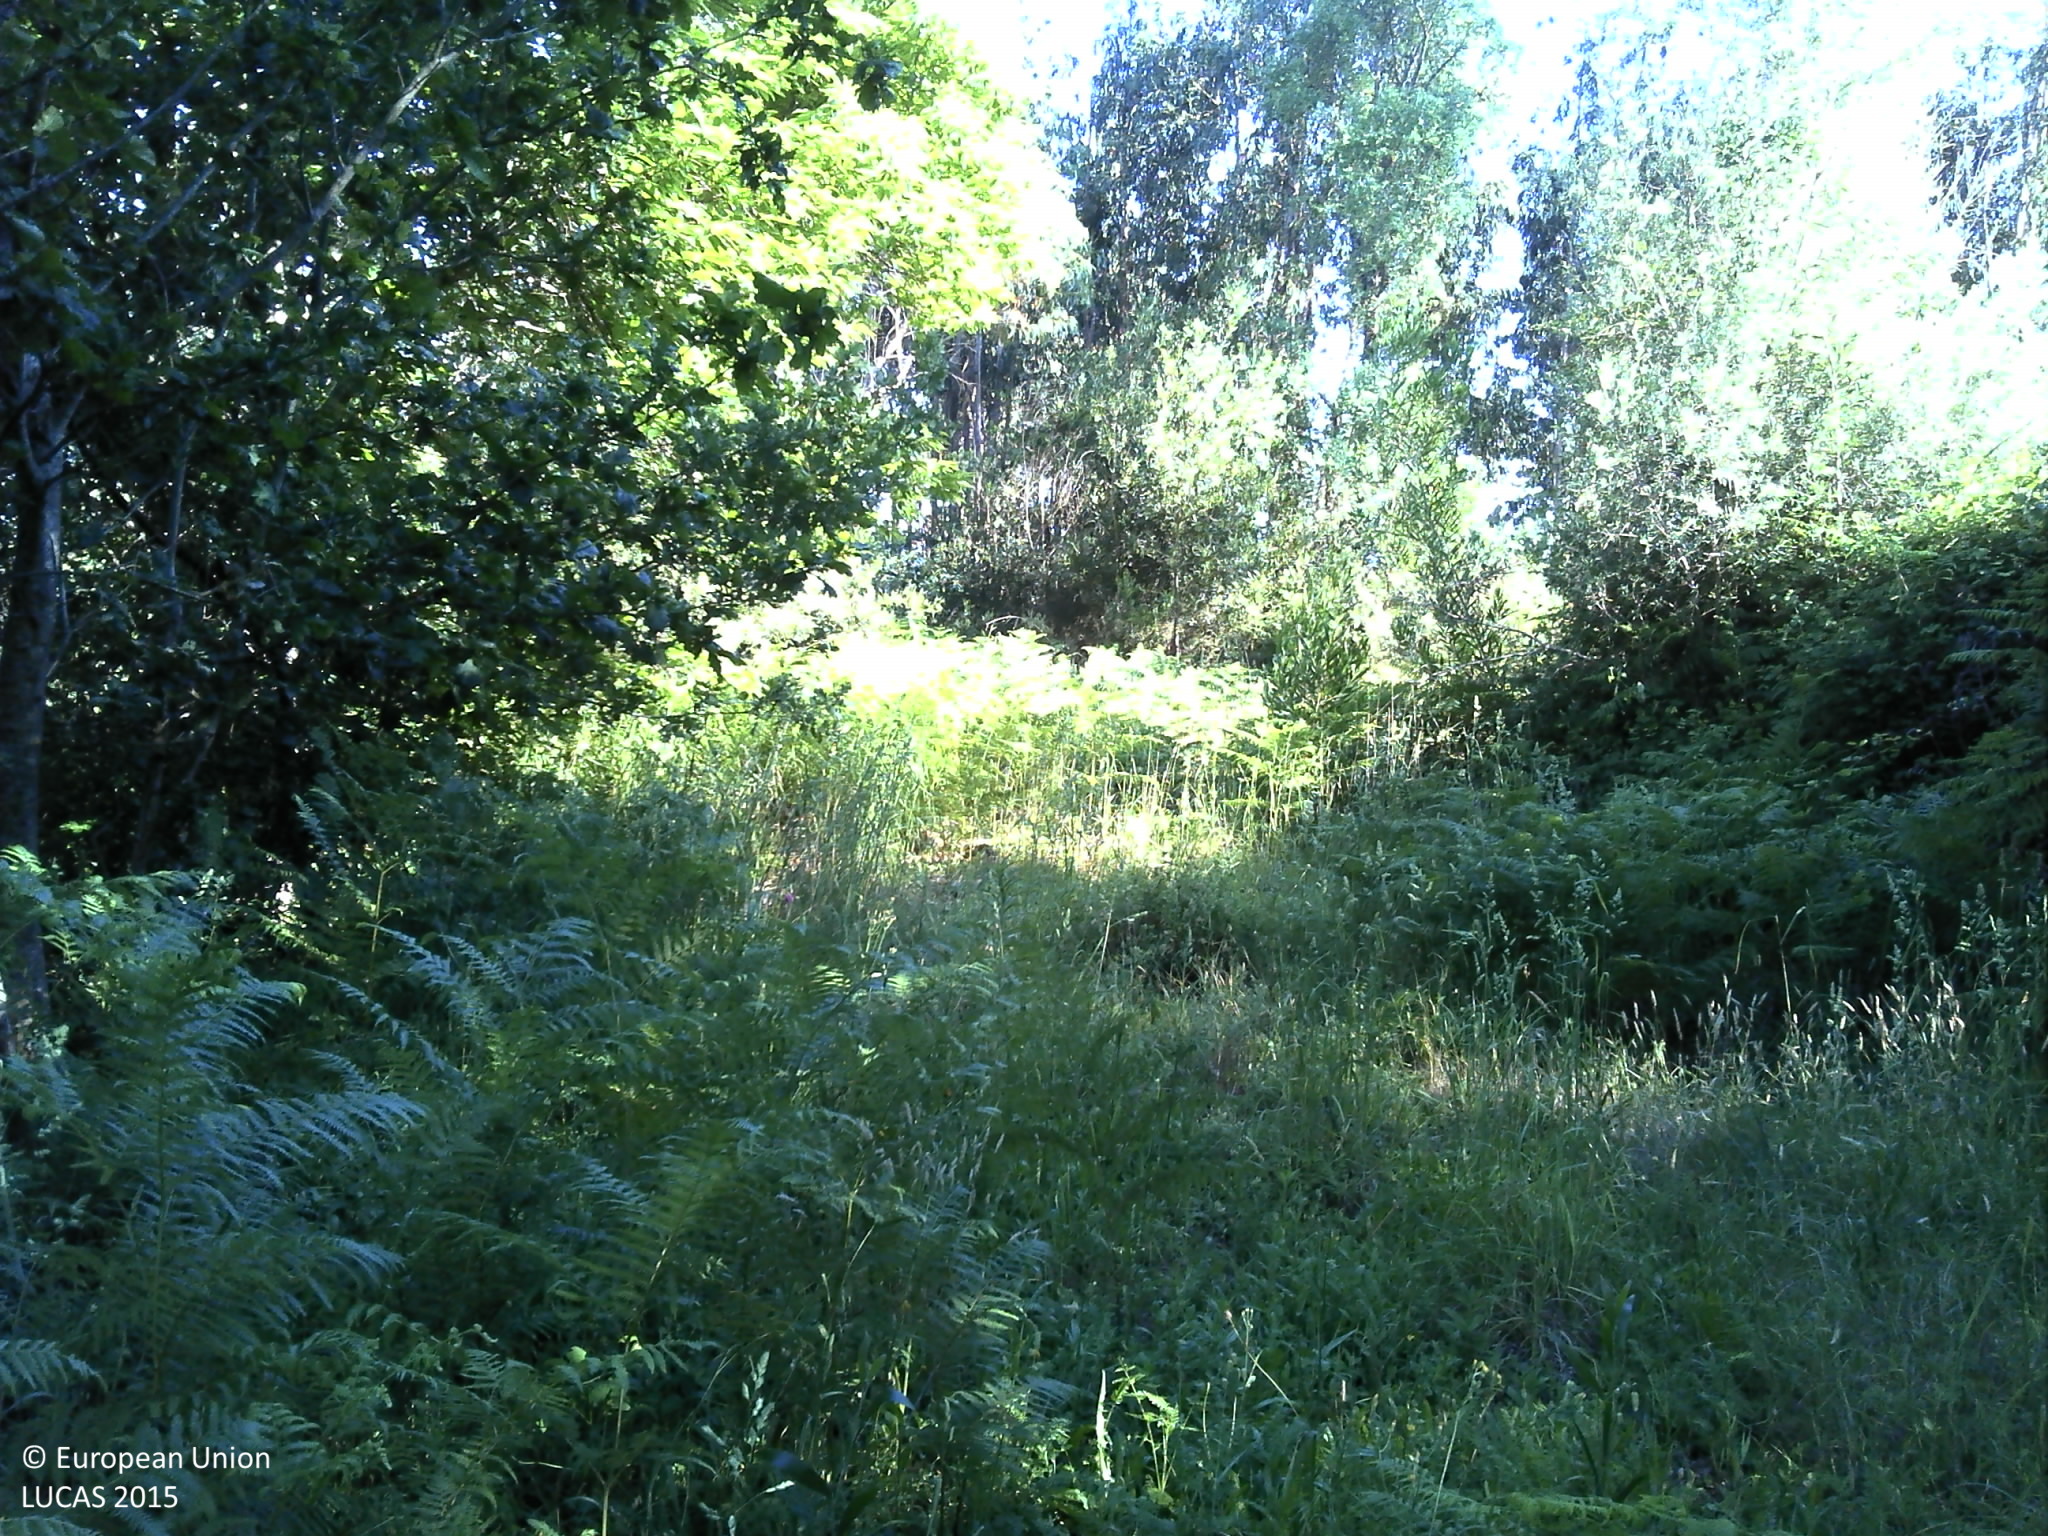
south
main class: Woodland
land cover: Broadleaved woodland
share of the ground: 25 - 50 %
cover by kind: broadleaved forest trees 35 %, herbaceous plants 35 %, unconsolidated bare surface 20 %, shrubs 10 %
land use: Forestry
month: May
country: PT
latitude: 41.7627
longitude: -8.7012
